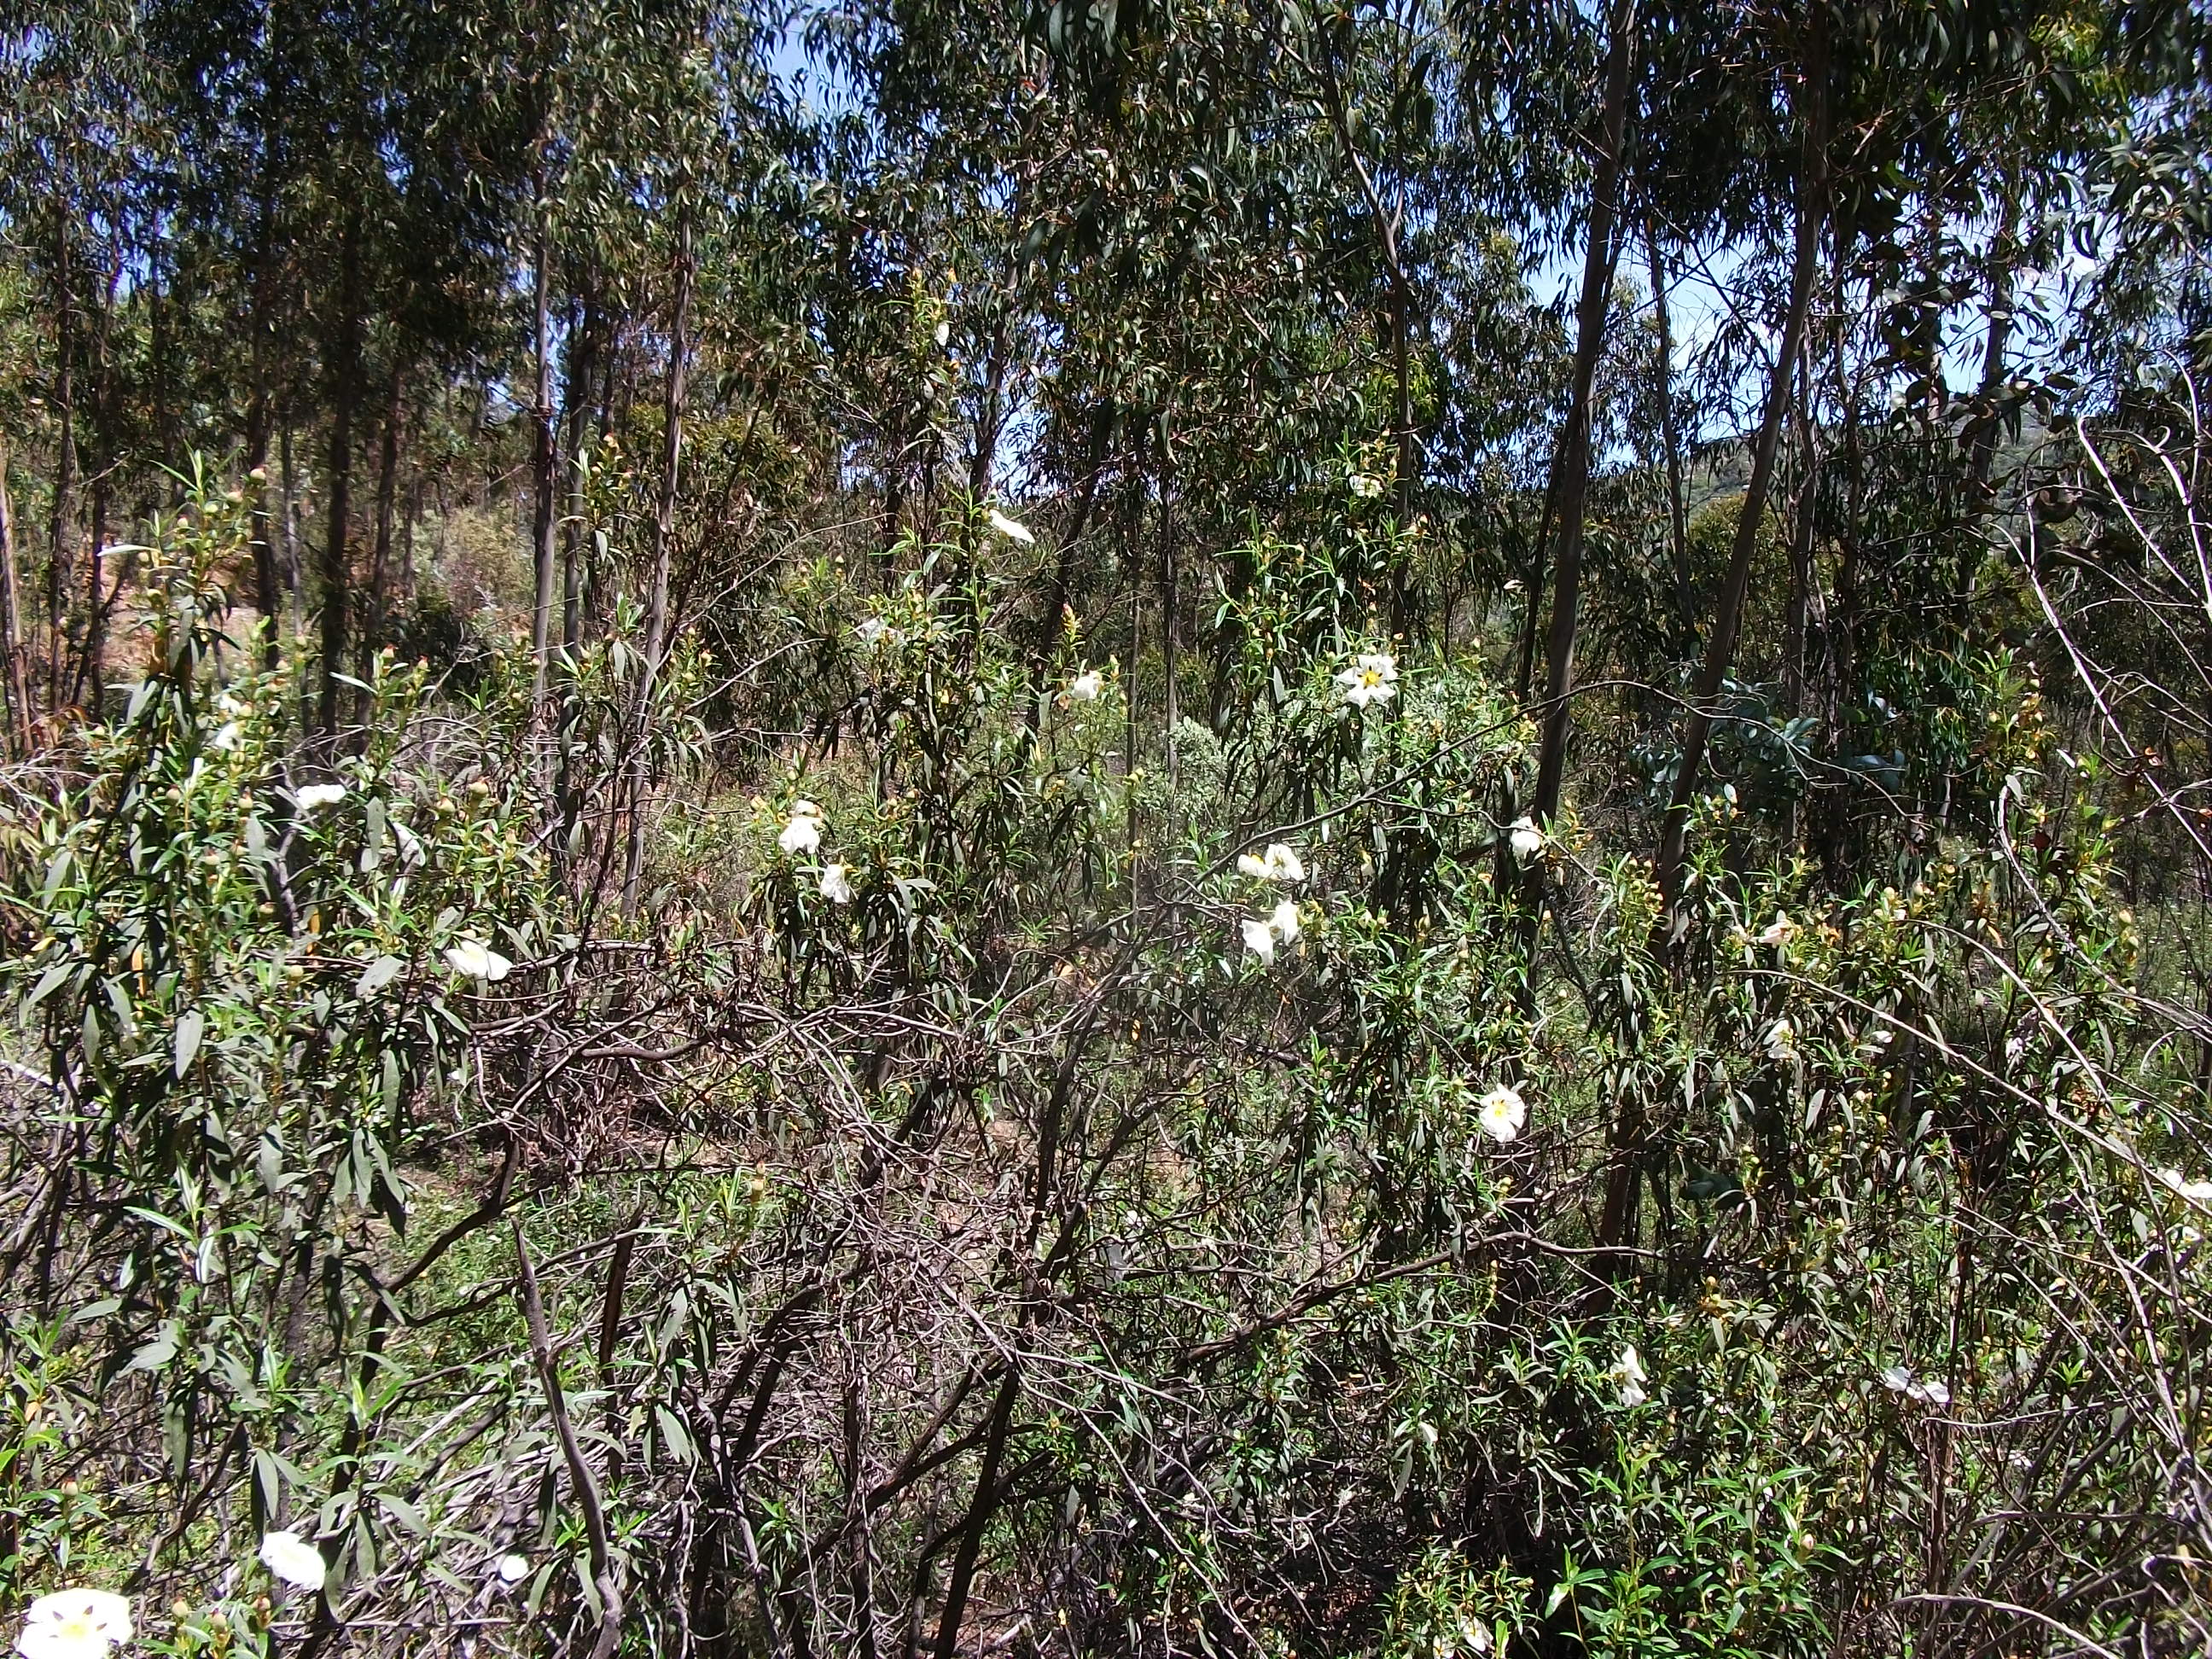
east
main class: Woodland
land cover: Broadleaved woodland
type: exotic forest
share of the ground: 50 - 75 %
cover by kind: broadleaved forest trees 60 %, shrubs 40 %
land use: Forestry
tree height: > 5 m
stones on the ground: 25 - 50 %
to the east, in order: Broadleaved woodland; Rivers and streams; Broadleaved woodland
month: May
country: ES
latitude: 37.9216
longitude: -7.1071
